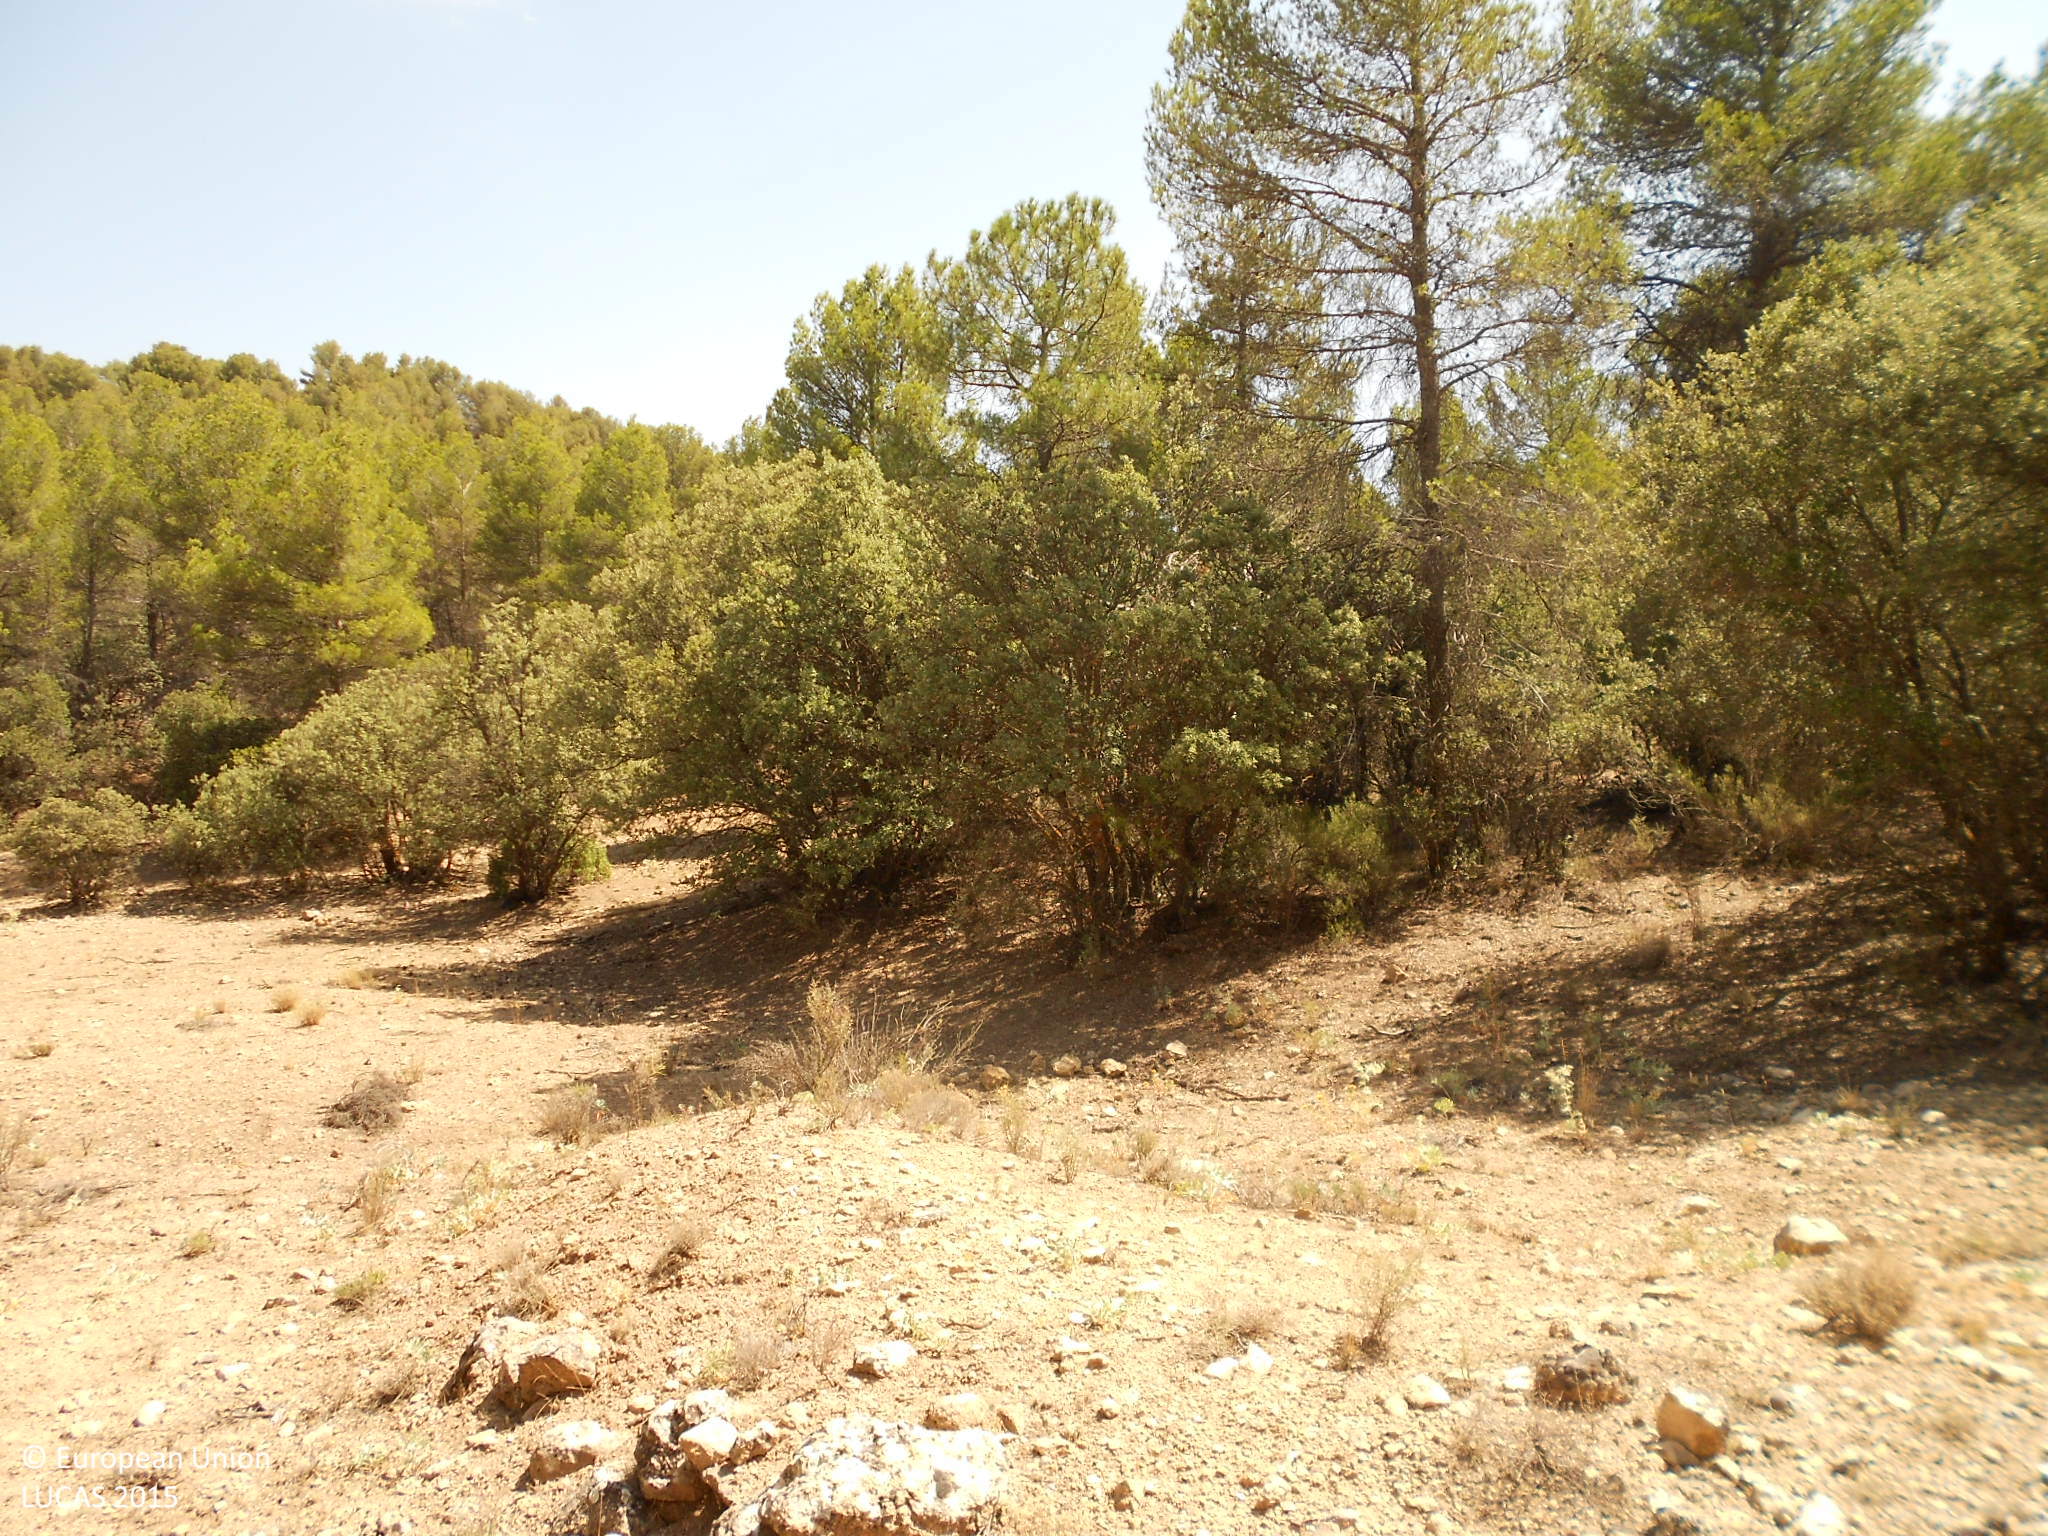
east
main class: Woodland
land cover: Other mixed woodland
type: coniferous forest of the mediterranean region
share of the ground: > 75 %
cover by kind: coniferous forest trees 40 %, broadleaved forest trees 40 %, shrubs 20 %
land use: Semi-natural and natural areas not in use
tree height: > 5 m
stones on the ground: 25 - 50 %
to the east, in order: Other mixed woodland; Rivers and streams; Other mixed woodland; Grassland with sparse tree/shrub cover; Other bare soil; Tracks; Broadleaved woodland; Tracks
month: August
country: ES
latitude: 37.6859
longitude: -2.2443
